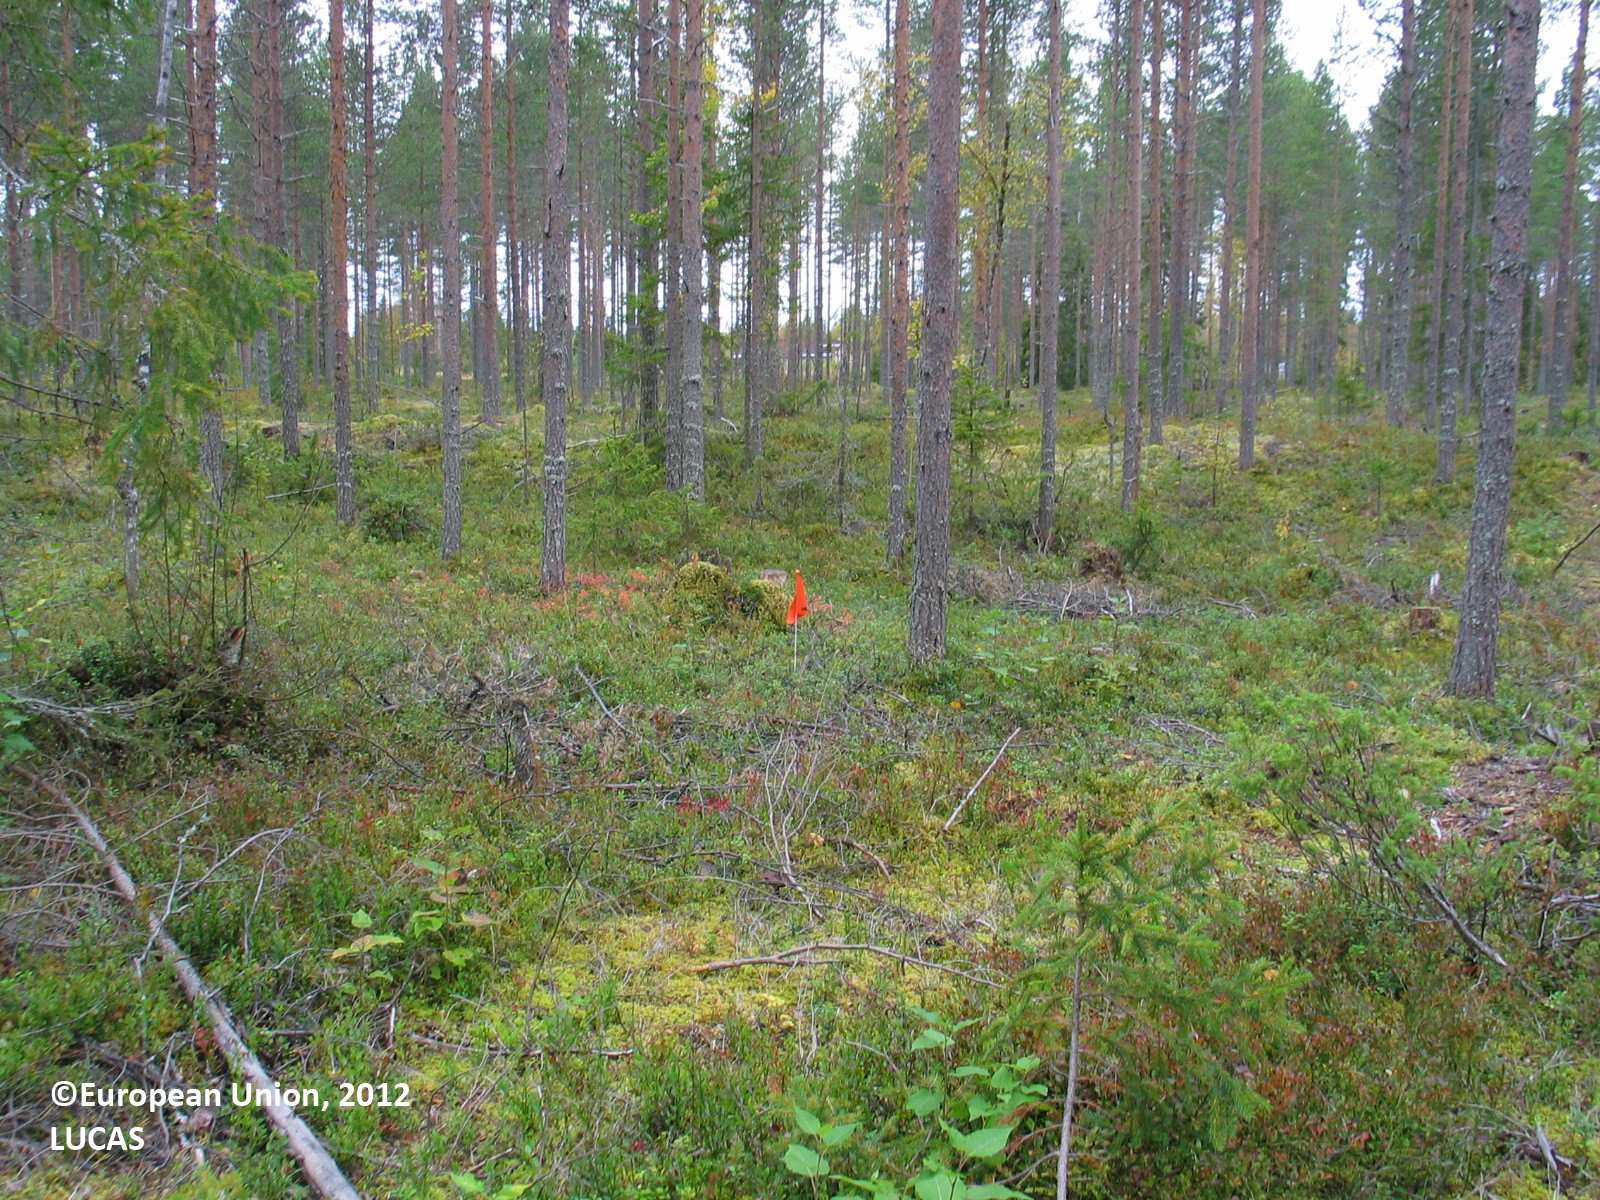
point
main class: Woodland
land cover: Pine dominated coniferous woodland
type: boreal forest
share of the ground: 25 - 50 %
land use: Forestry
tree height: > 5 m
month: September
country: FI
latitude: 65.4701
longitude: 25.6008
